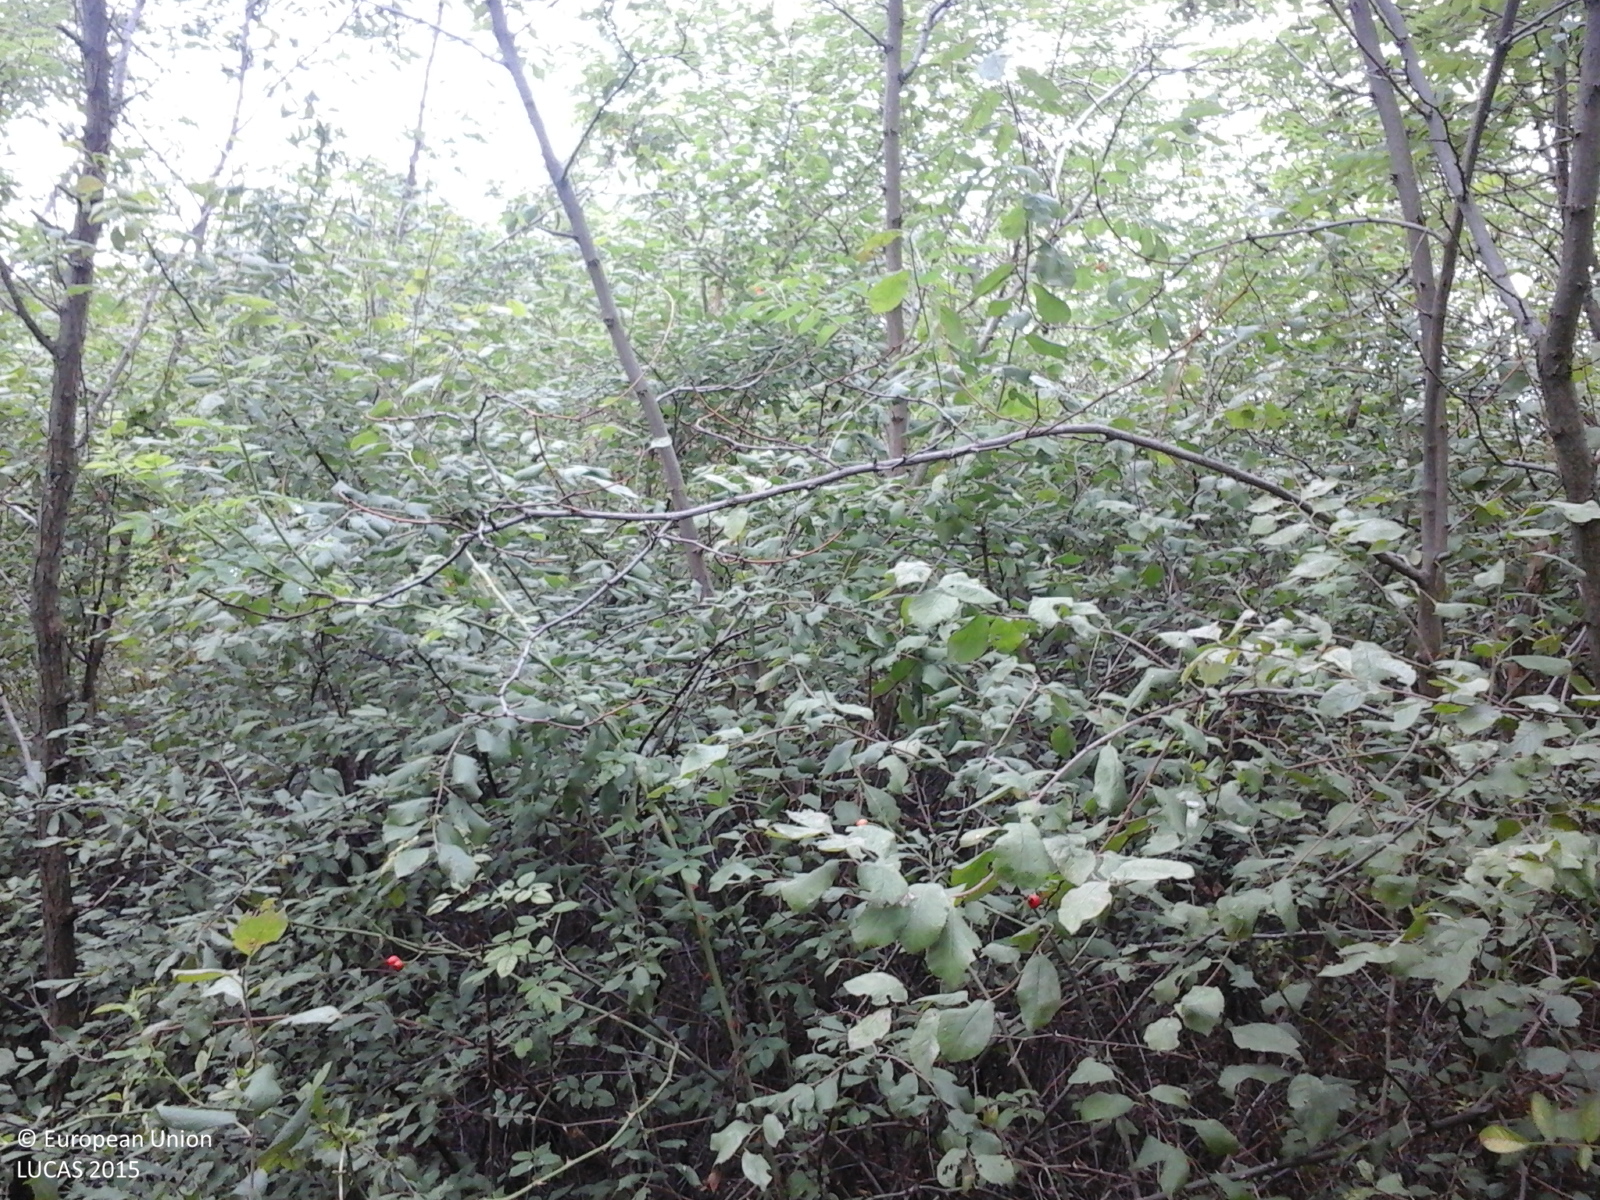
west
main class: Woodland
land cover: Broadleaved woodland
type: exotic forest
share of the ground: > 75 %
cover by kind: broadleaved forest trees 100 %
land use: Forestry
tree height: > 5 m
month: September
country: RO
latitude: 47.1697
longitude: 22.1211
